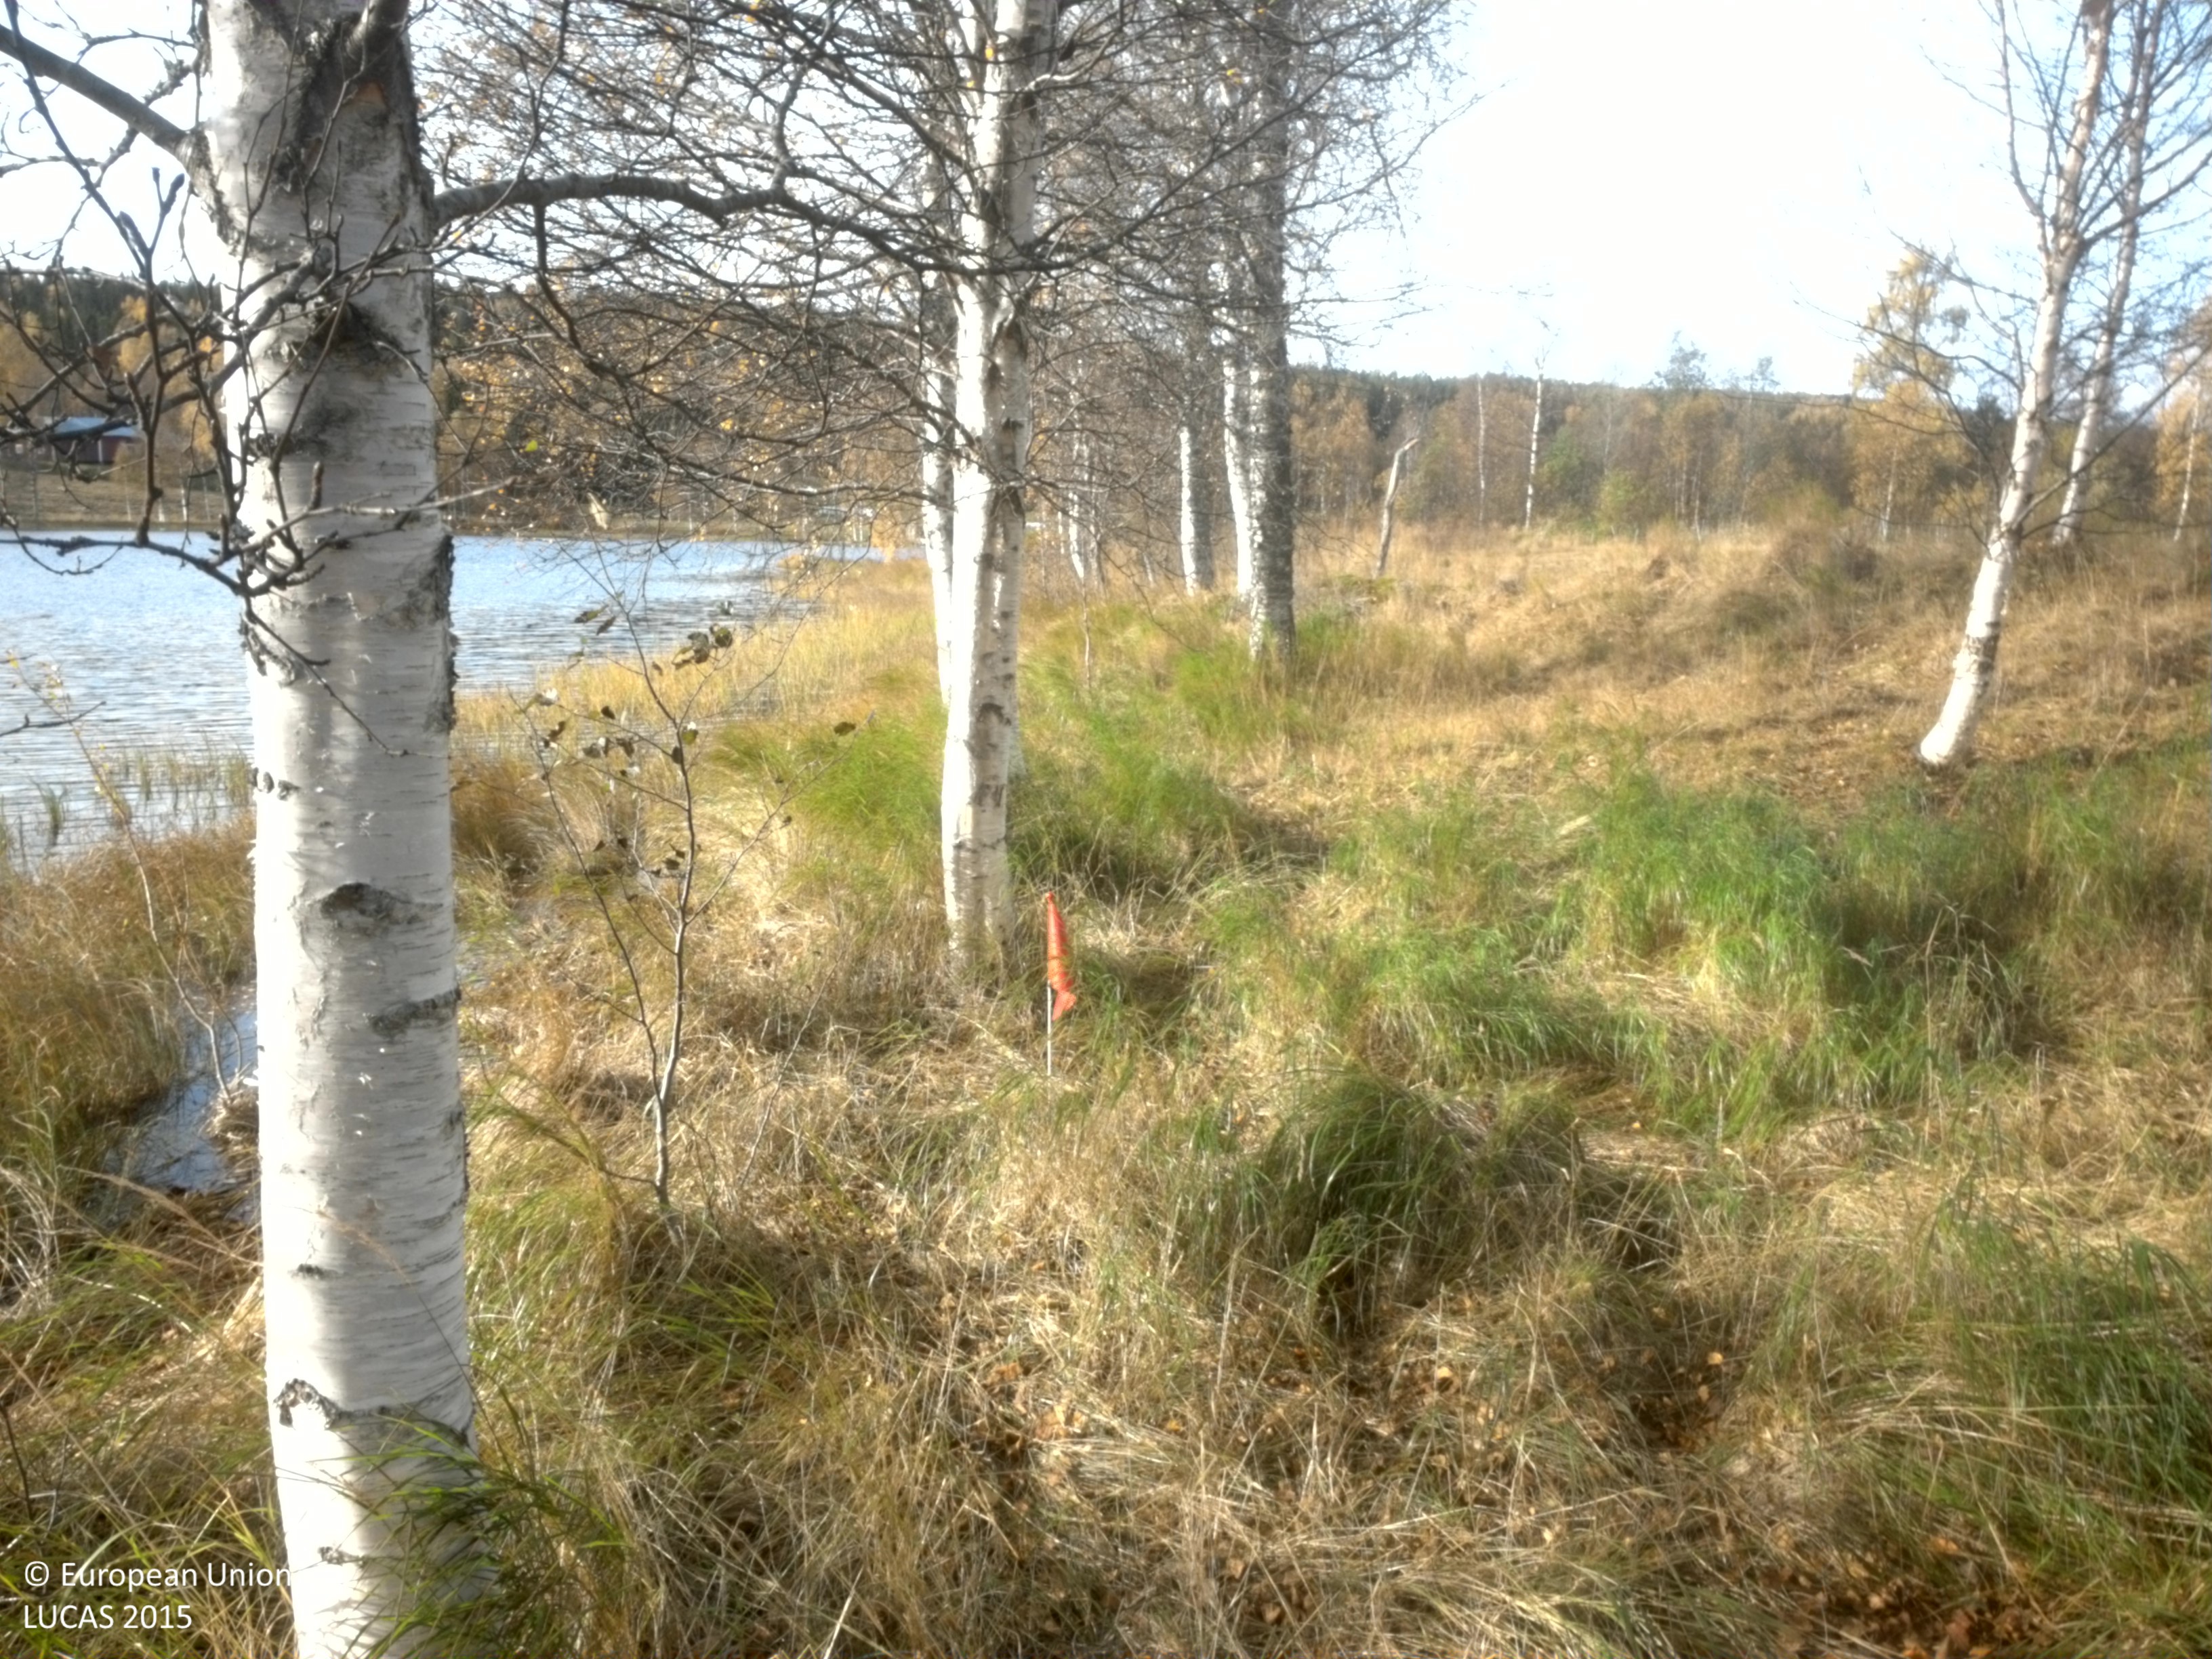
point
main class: Woodland
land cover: Broadleaved woodland
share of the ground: 25 - 50 %
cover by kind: herbaceous plants 60 %, broadleaved forest trees 40 %
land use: Semi-natural and natural areas not in use
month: October
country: SE
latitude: 64.0790
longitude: 20.0455
